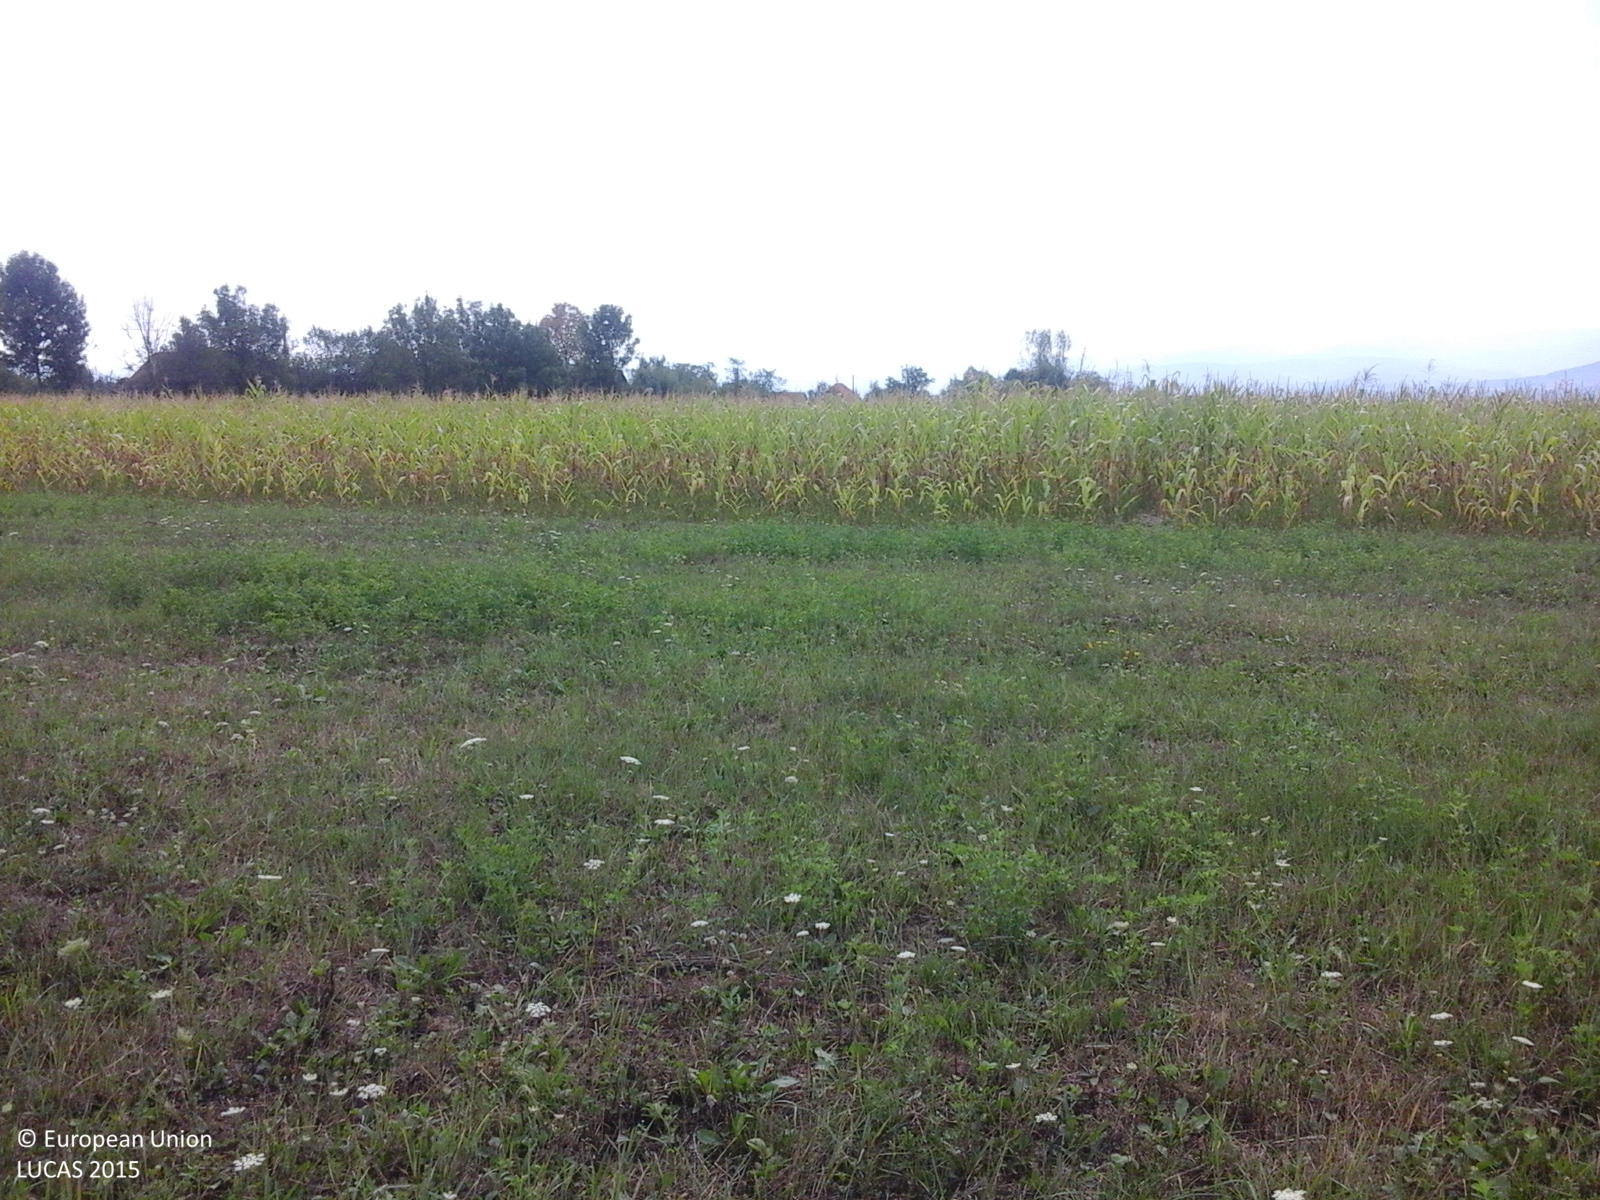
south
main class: Grassland
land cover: Grassland without tree/shrub cover
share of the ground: > 75 %
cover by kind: herbaceous plants 100 %
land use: Agriculture (excluding fallow land and kitchen gardens)
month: August
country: RO
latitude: 46.3188
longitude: 22.2416
